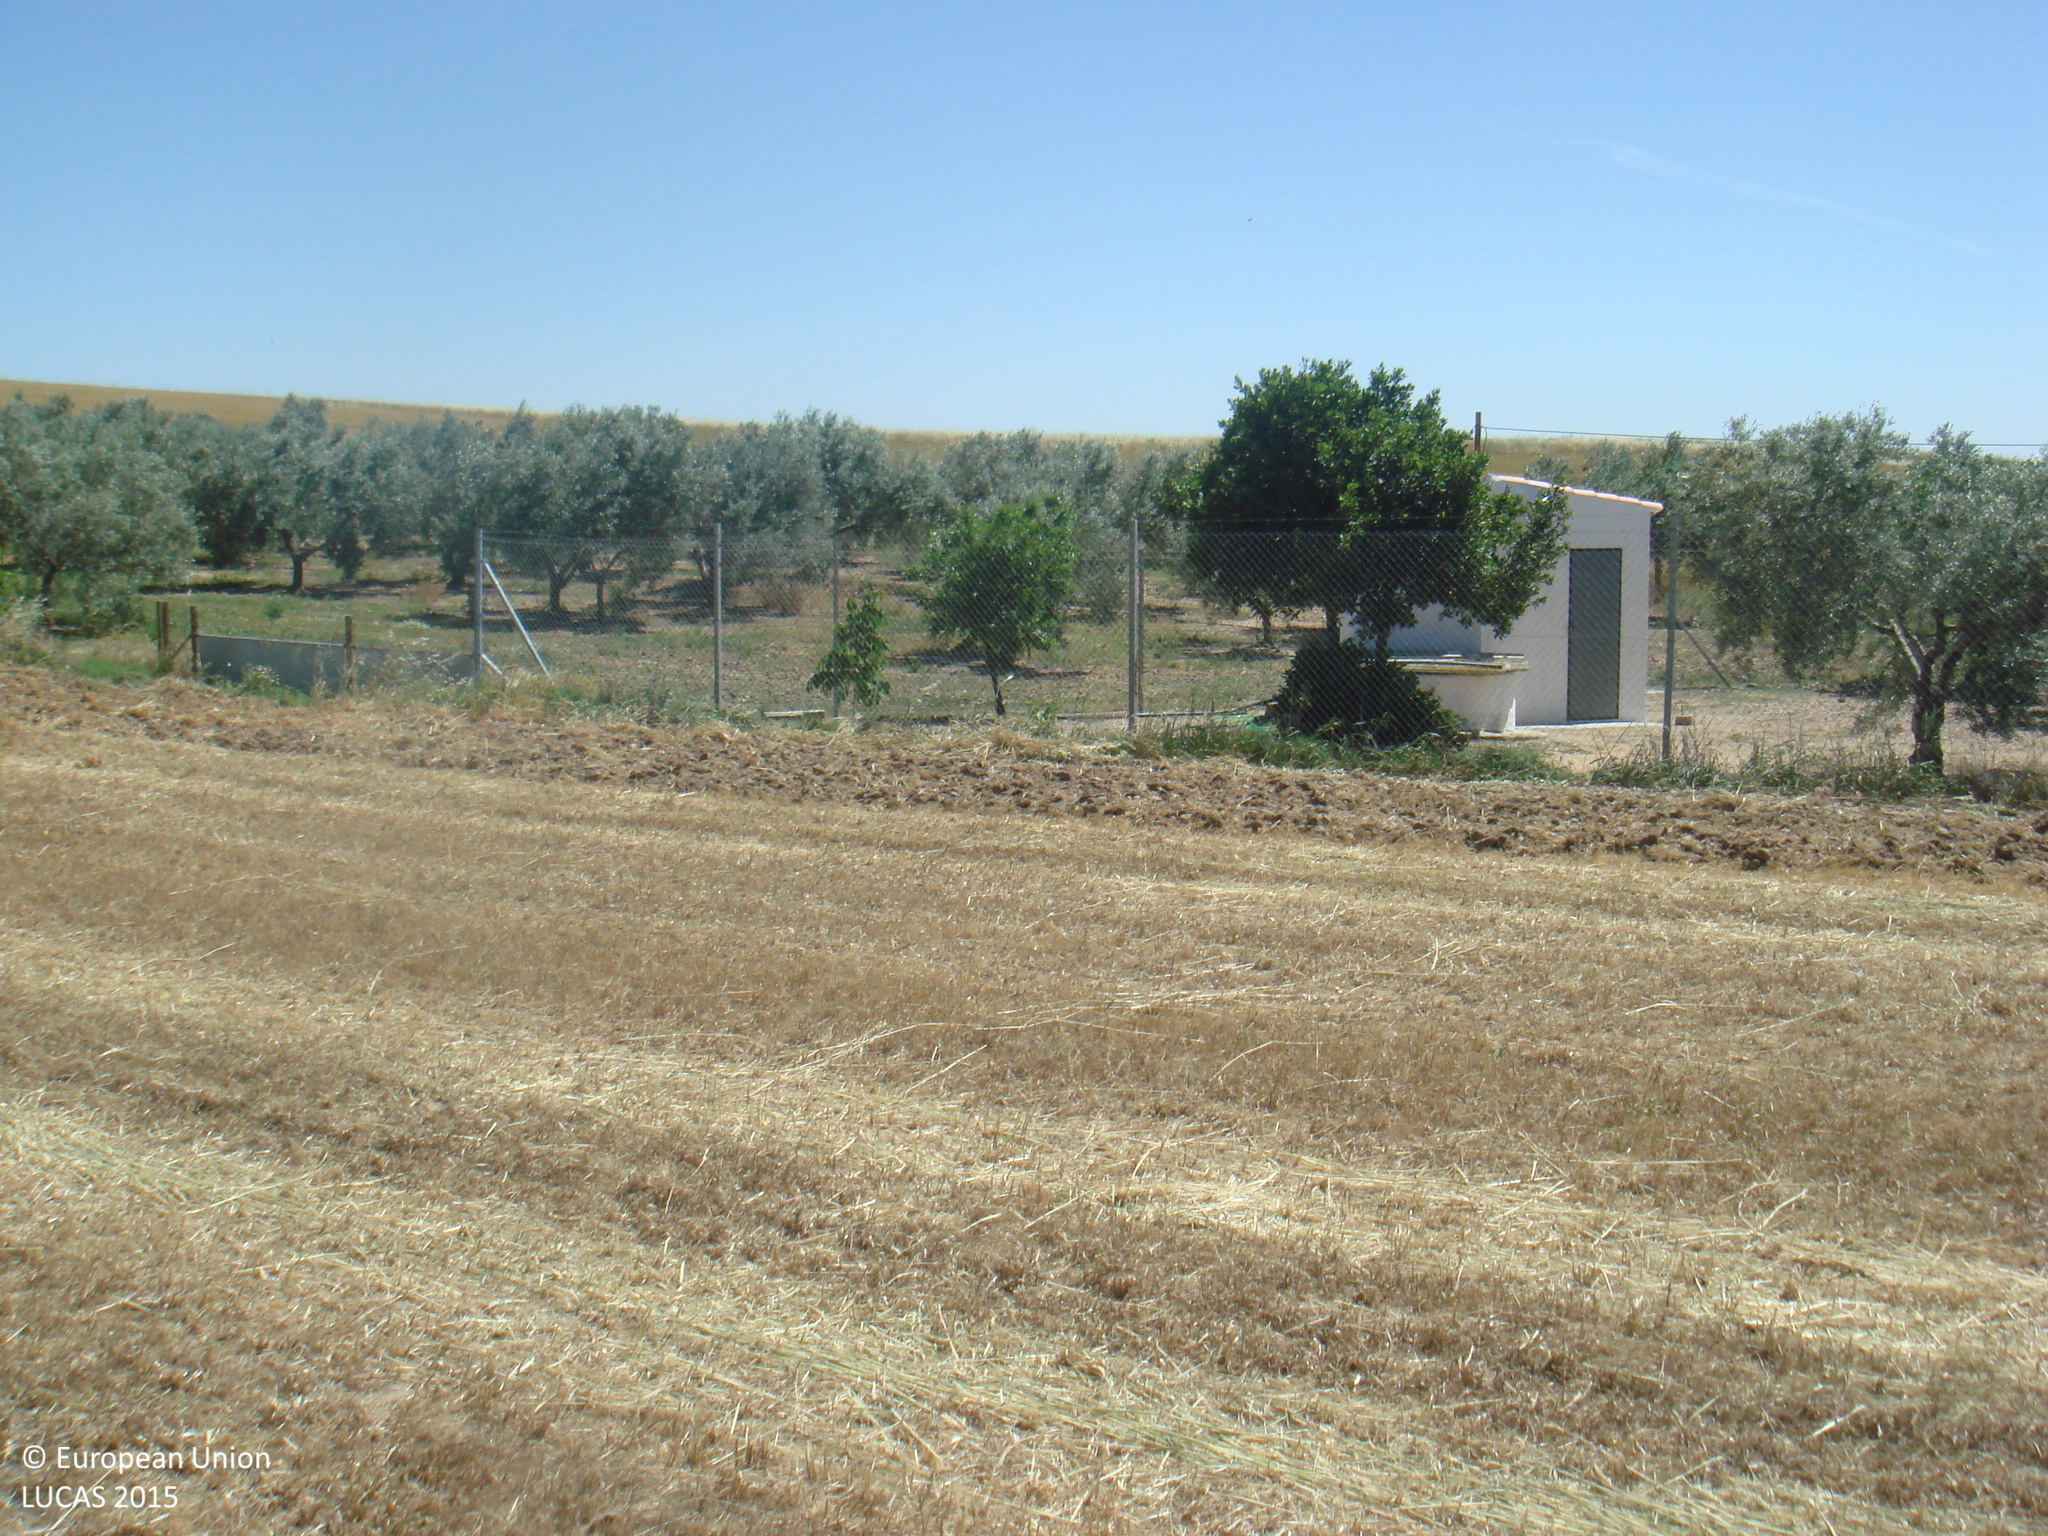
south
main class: Cropland
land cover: Barley
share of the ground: > 75 %
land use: Agriculture (excluding fallow land and kitchen gardens)
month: May
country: ES
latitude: 38.5691
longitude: -5.1466
